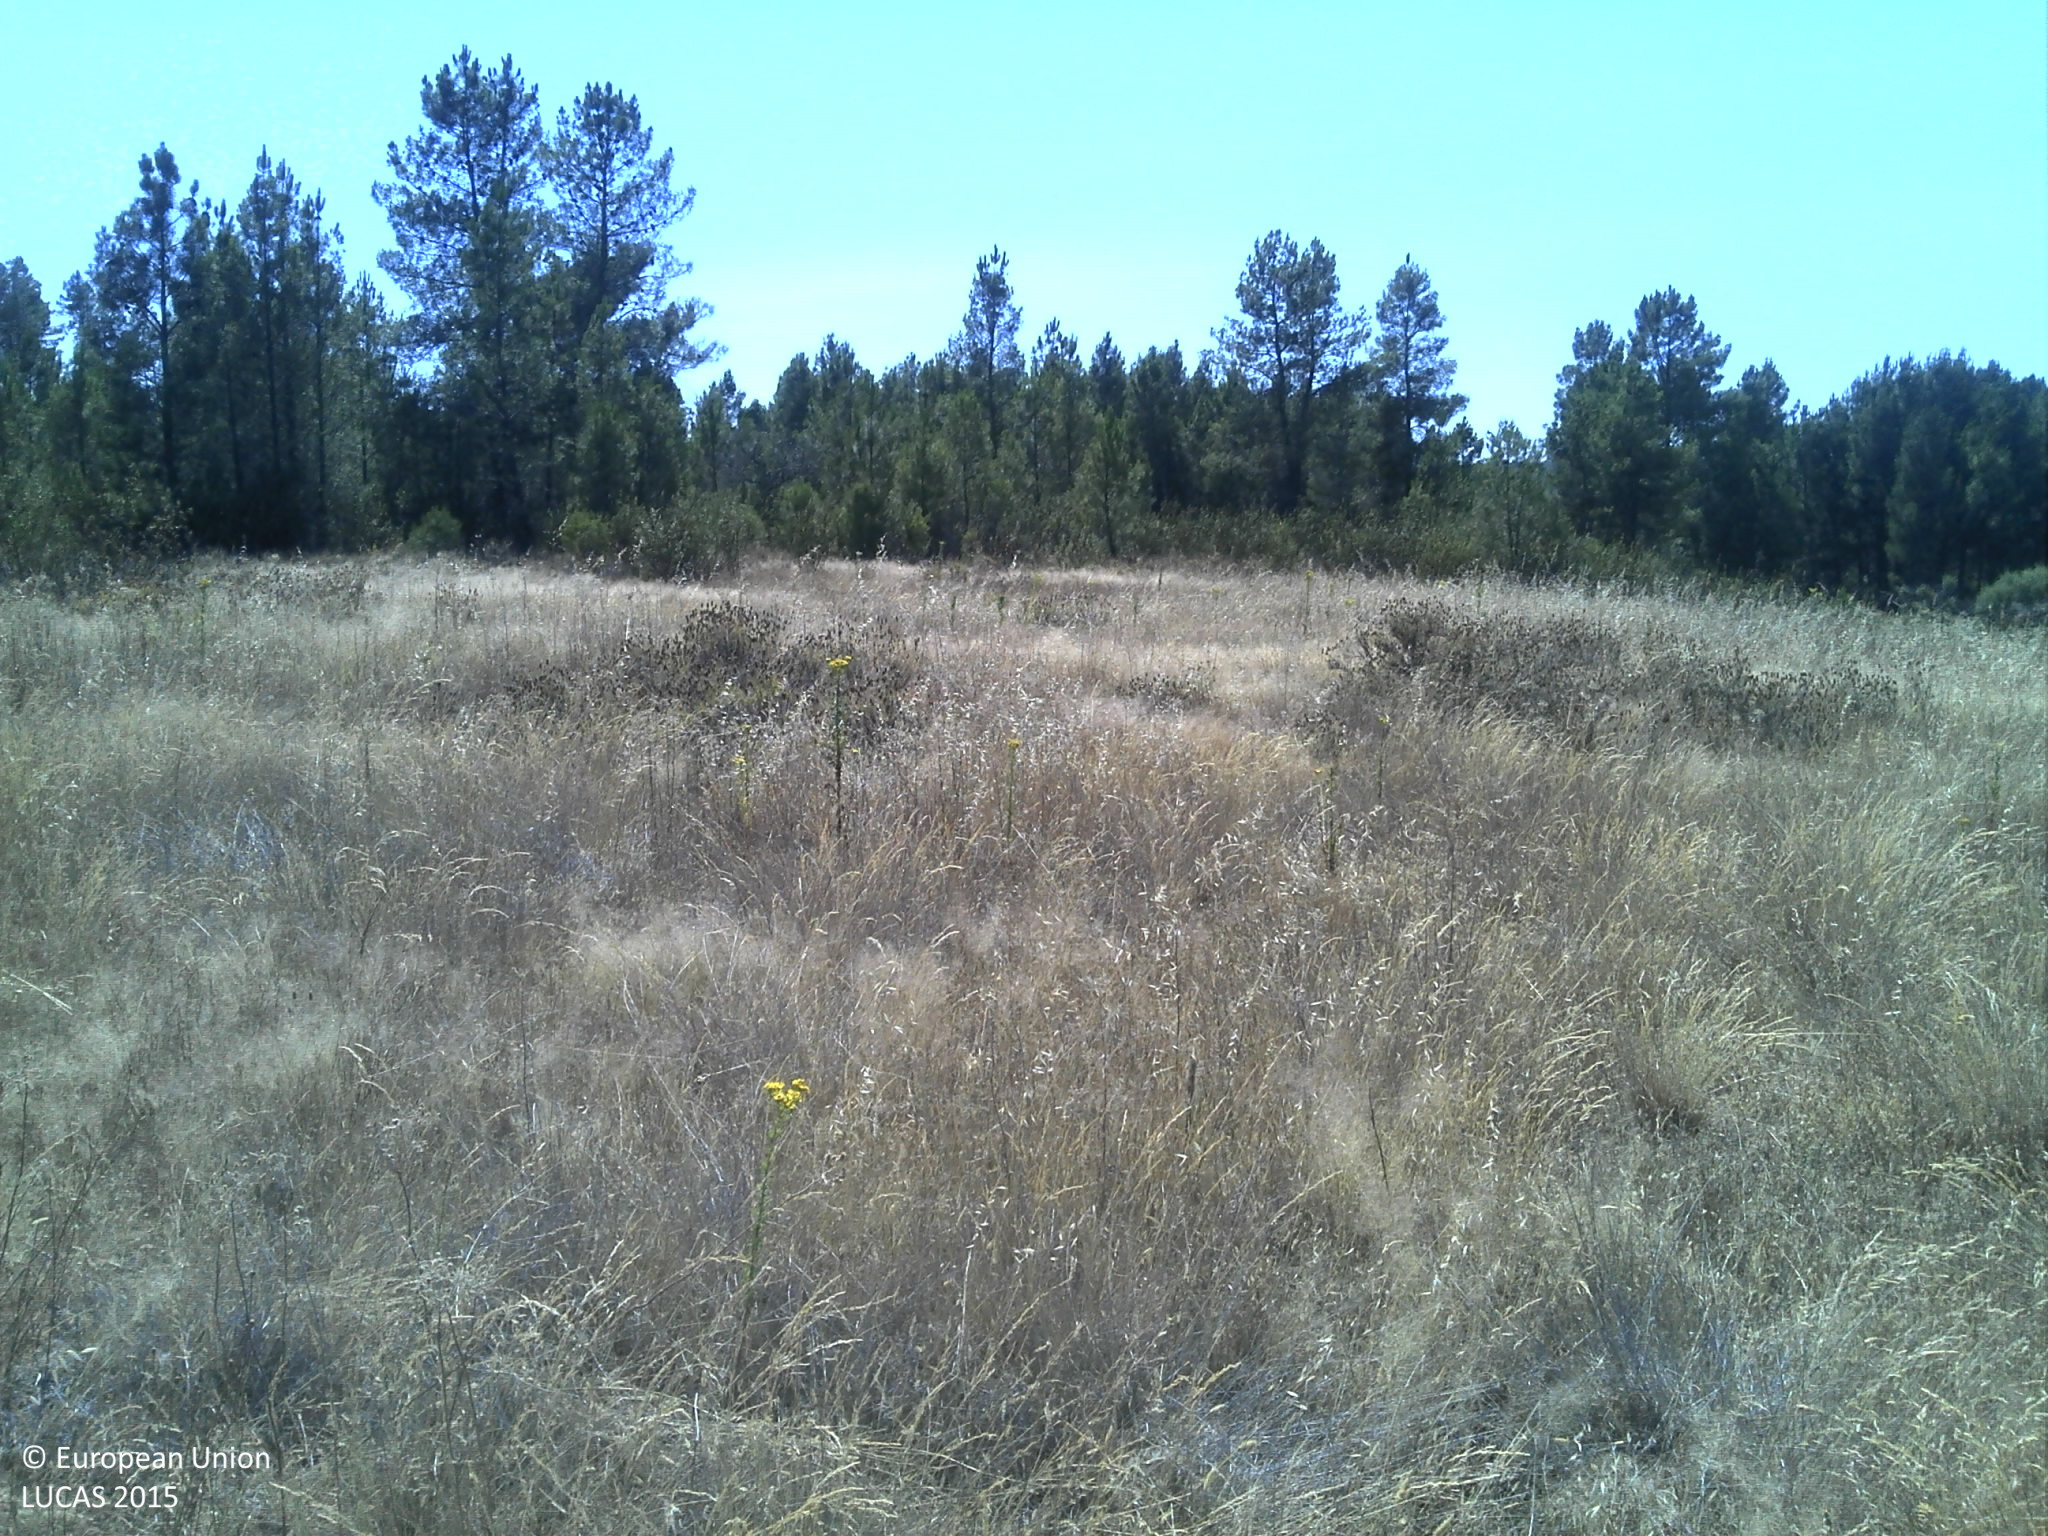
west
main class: Grassland
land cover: Grassland with sparse tree/shrub cover
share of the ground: 25 - 50 %
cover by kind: herbaceous plants 50 %, unconsolidated bare surface 40 %, broadleaved forest trees 5 %, shrubs 5 %
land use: Agriculture (excluding fallow land and kitchen gardens)
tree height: < 5 m
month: July
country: PT
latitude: 39.8711
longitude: -7.6525
